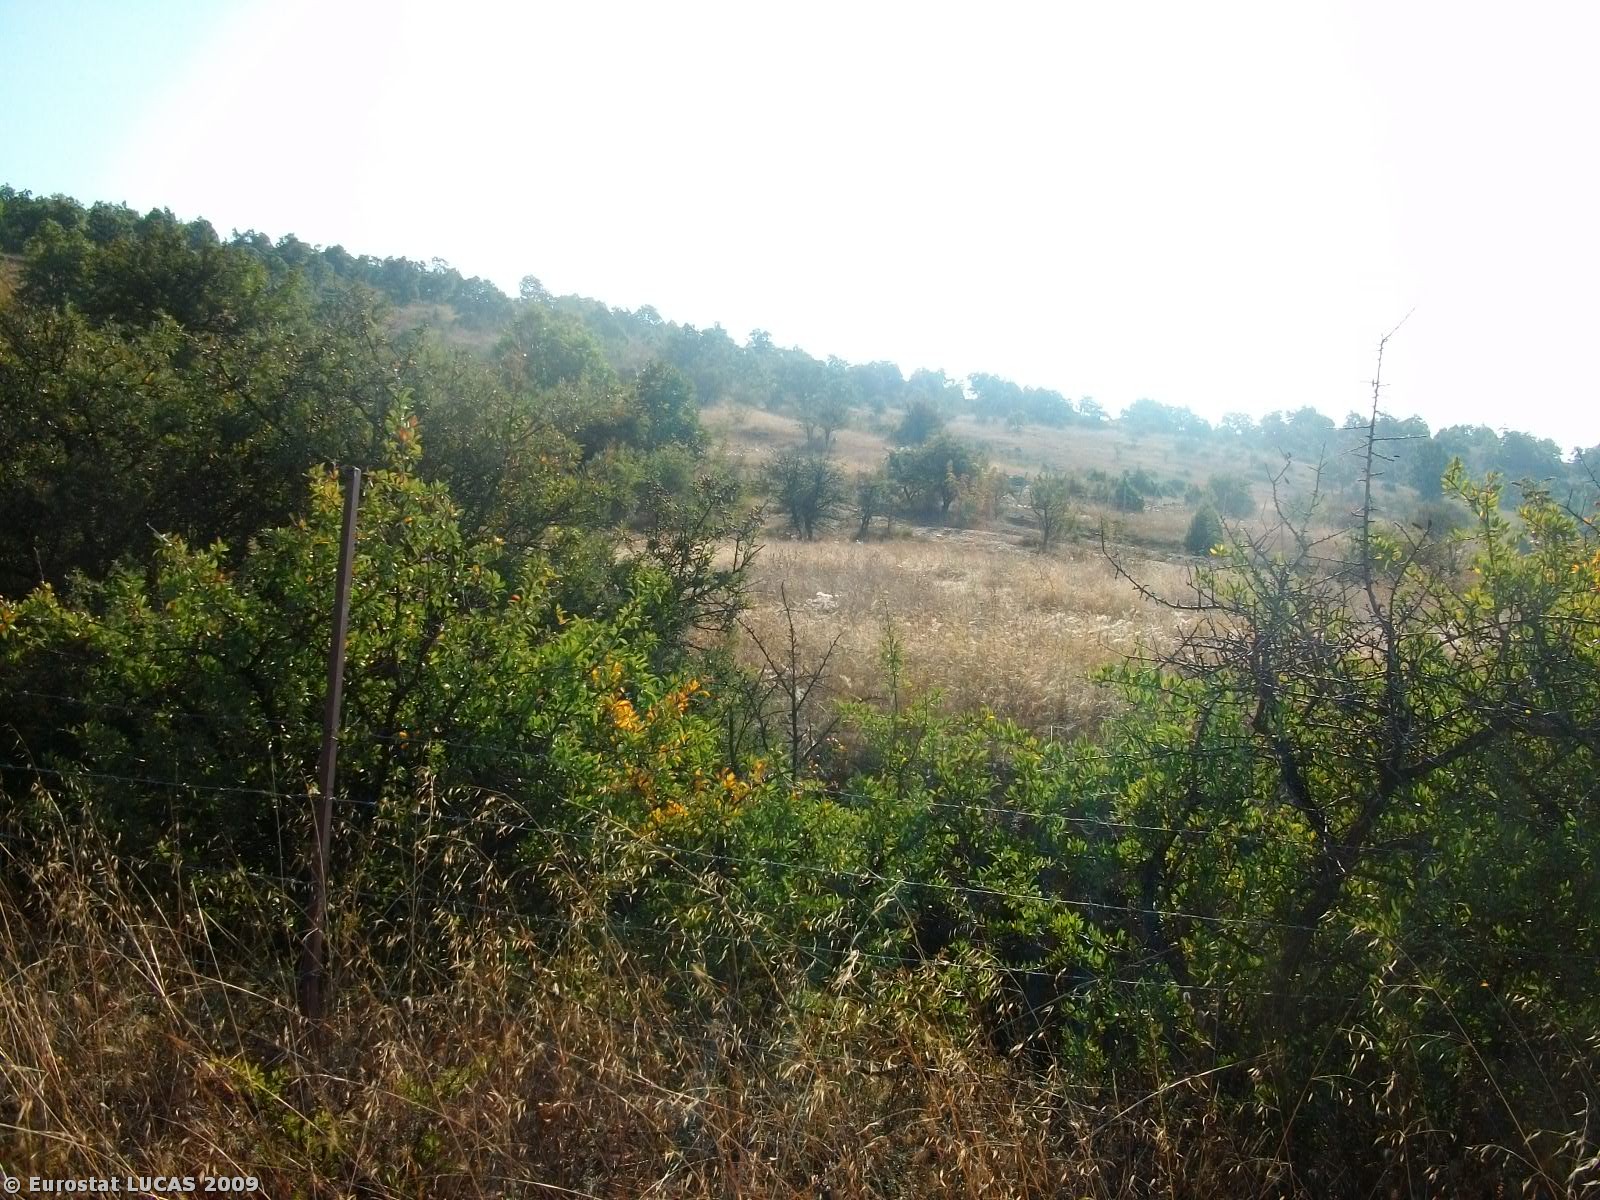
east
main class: Cropland
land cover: Vineyards
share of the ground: < 10 %
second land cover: Grassland with sparse tree/shrub cover
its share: > 75 %
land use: Agriculture (excluding fallow land and kitchen gardens)
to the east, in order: Vineyards; Grassland with sparse tree/shrub cover; Fences; Shrubland with sparse tree cover; Spontaneously vegetated surfaces; Grassland with sparse tree/shrub cover; Bare land
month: May
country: GR
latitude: 40.7870
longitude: 21.8599
